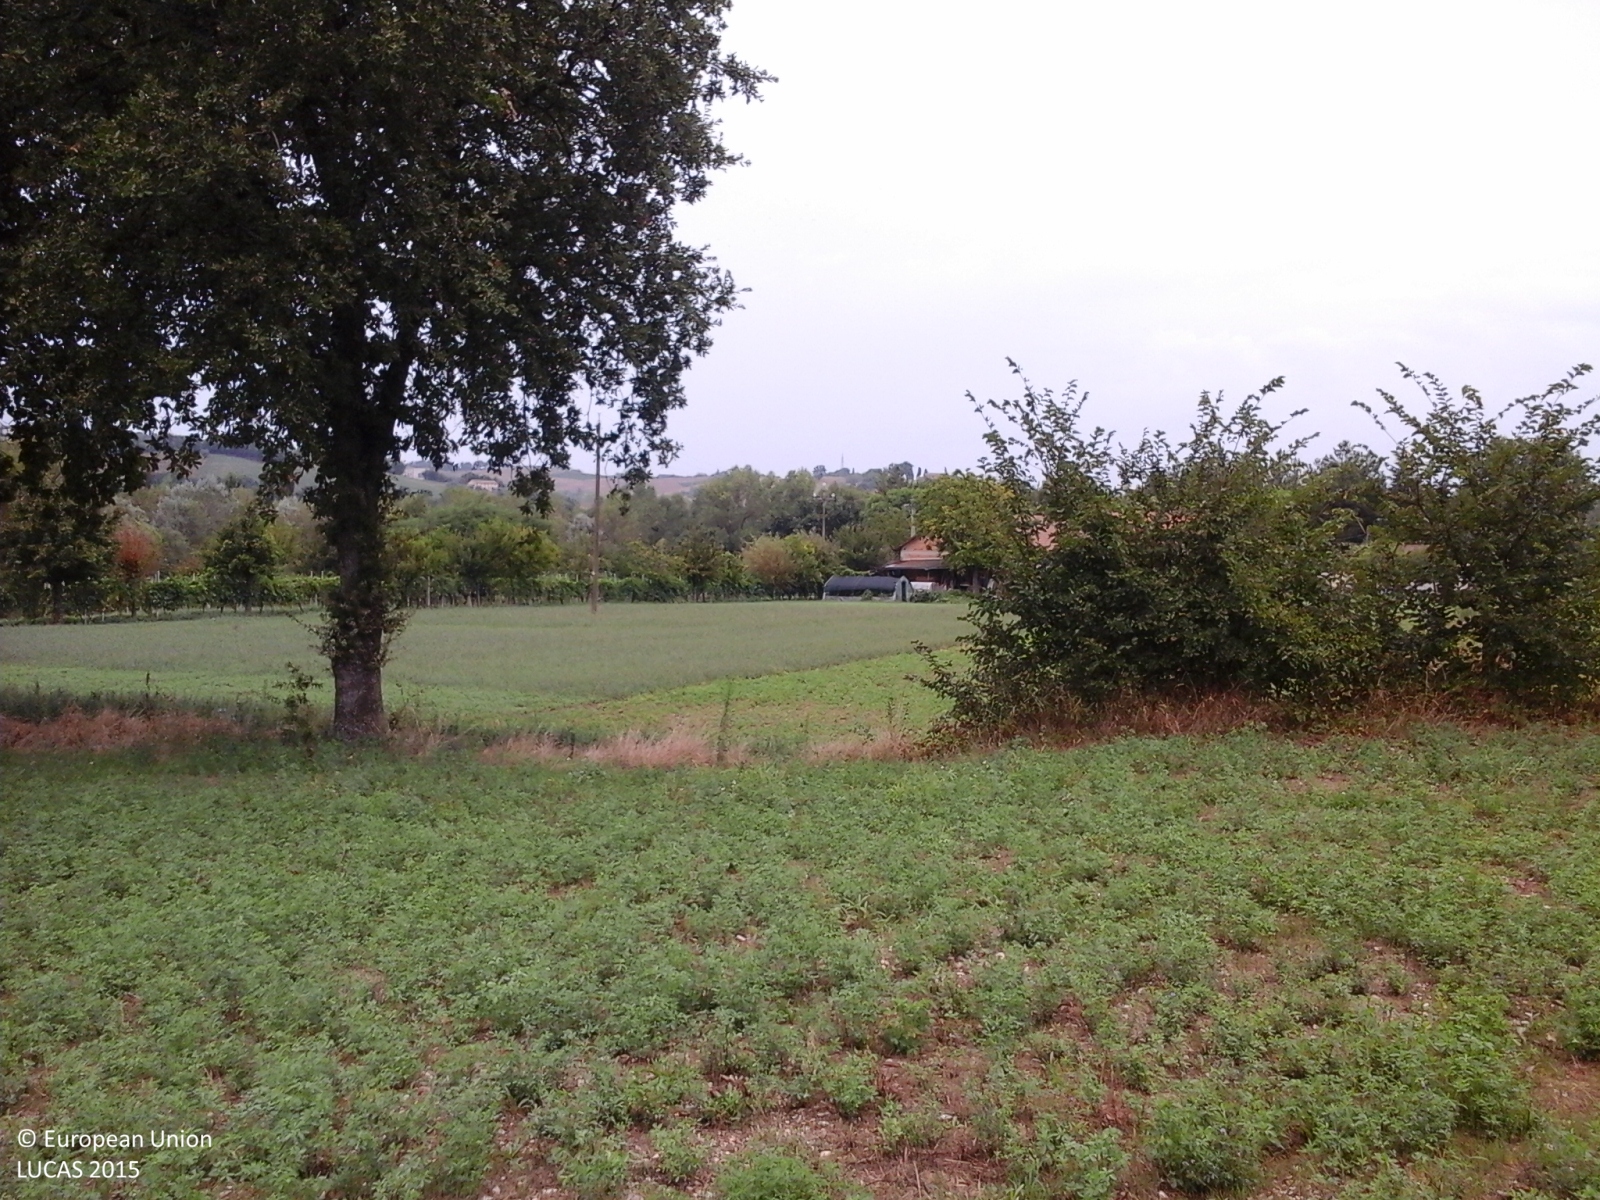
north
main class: Cropland
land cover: Lucerne
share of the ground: > 75 %
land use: Agriculture (excluding fallow land and kitchen gardens)
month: August
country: IT
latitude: 43.6572
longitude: 13.0058
